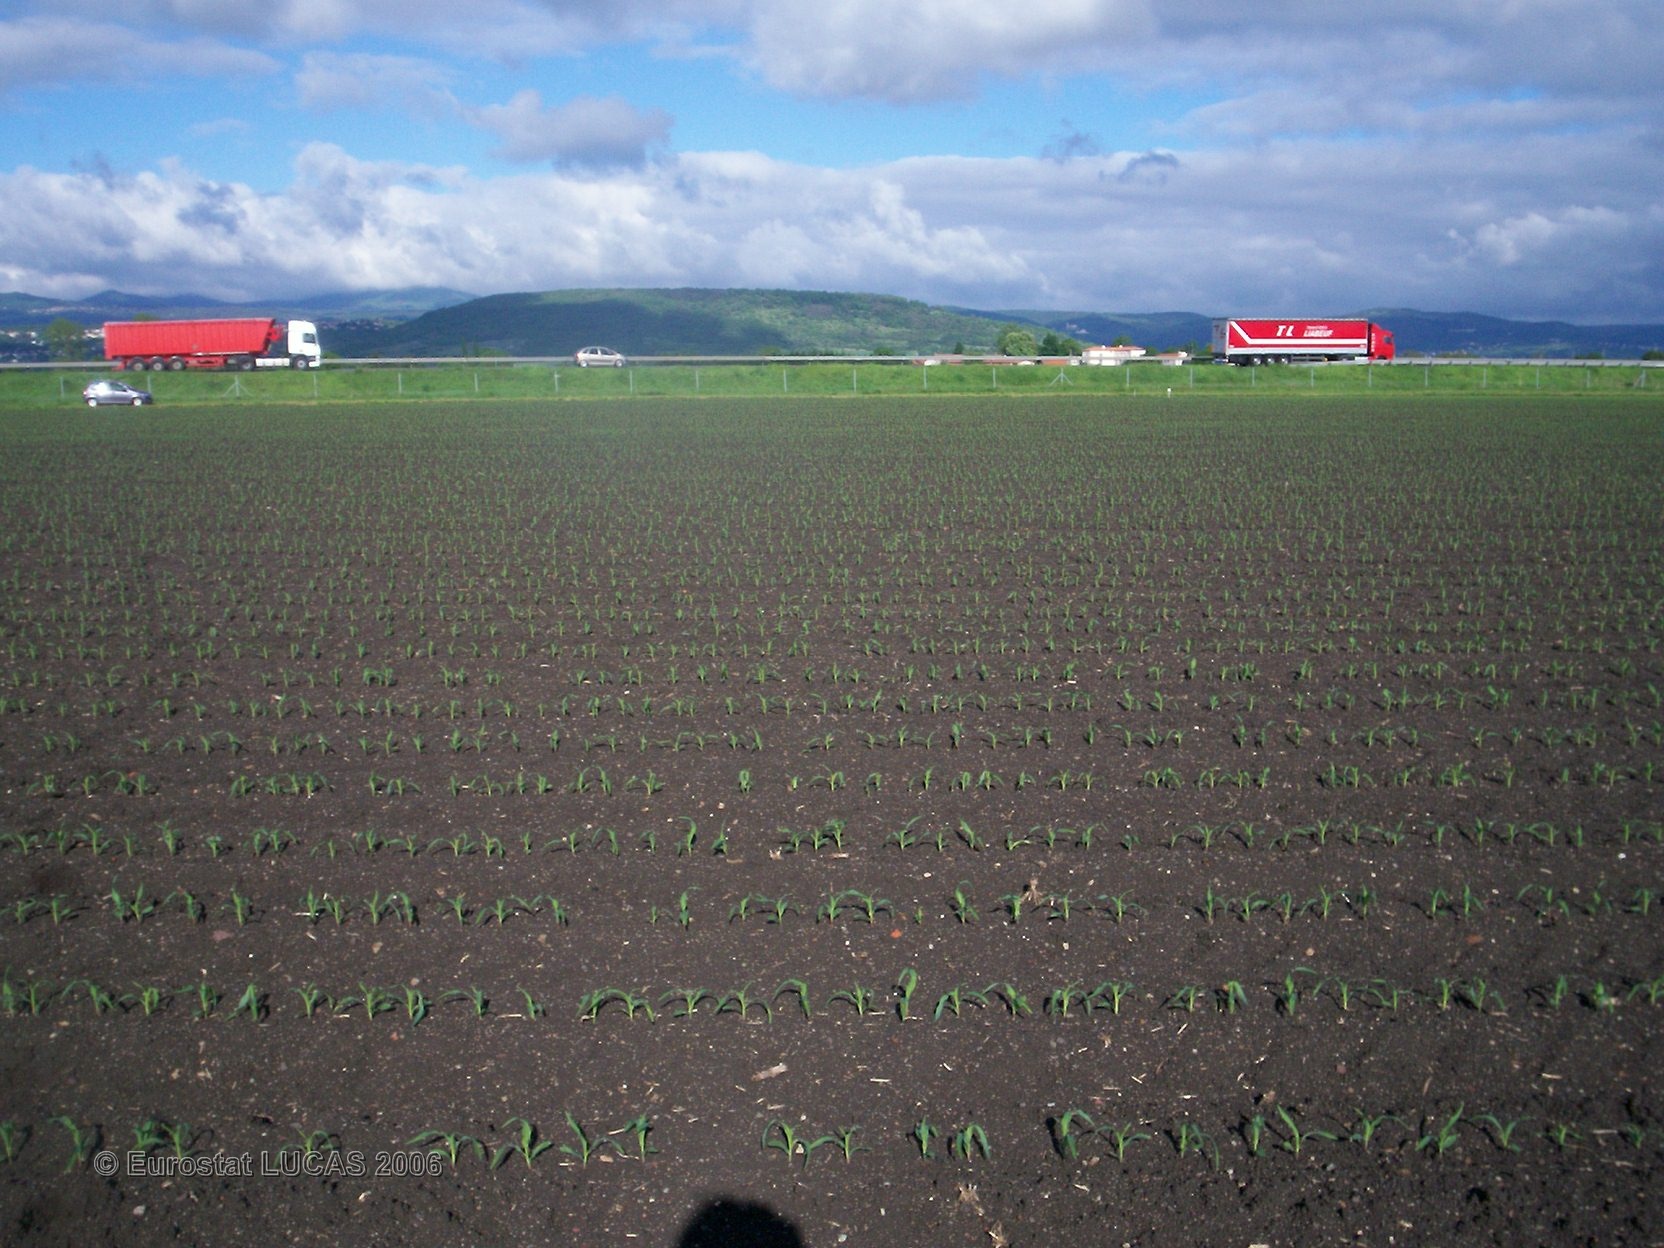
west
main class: Cropland
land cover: Maize
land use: Agriculture (excluding fallow land and kitchen gardens)
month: May
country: FR
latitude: 45.8610
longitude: 3.1603
